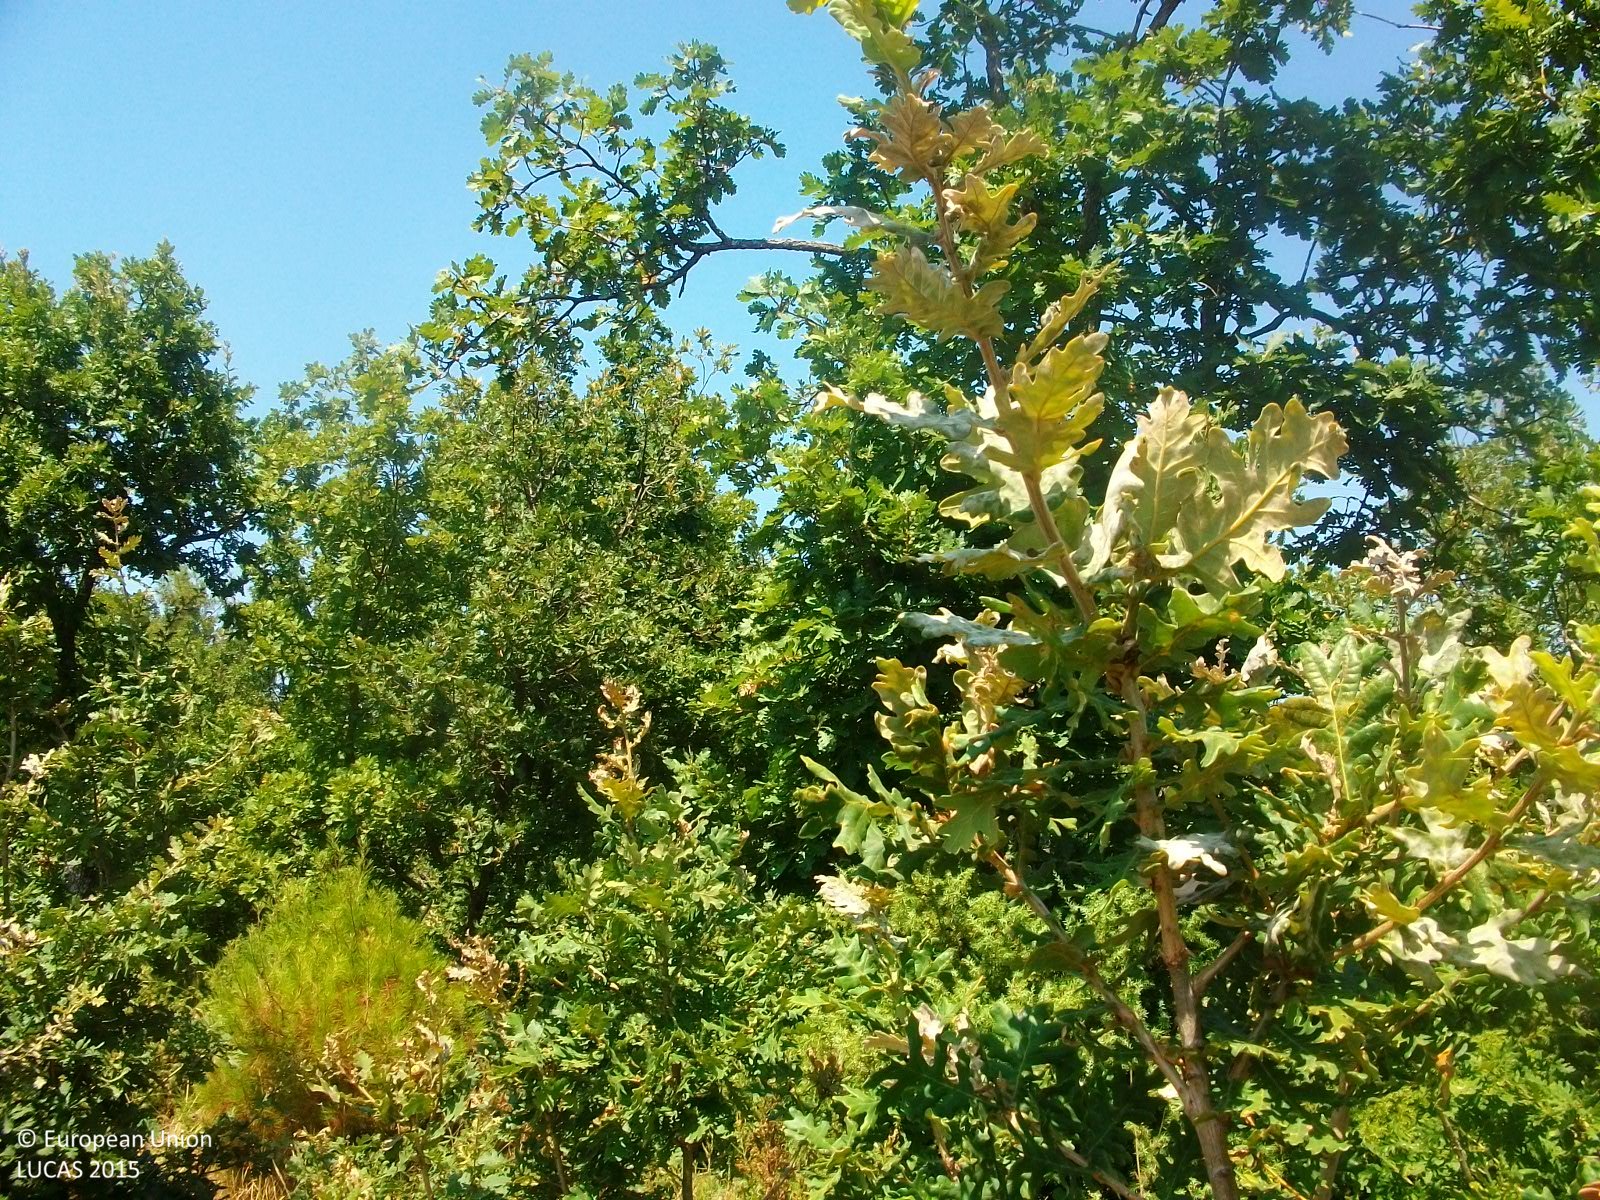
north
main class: Woodland
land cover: Broadleaved woodland
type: thermophilous deciduous forest
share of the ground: > 75 %
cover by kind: broadleaved forest trees 80 %, shrubs 10 %, herbaceous plants 10 %
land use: Forestry
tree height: > 5 m
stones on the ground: 10 - 25 %
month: August
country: GR
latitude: 41.2317
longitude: 26.1859
